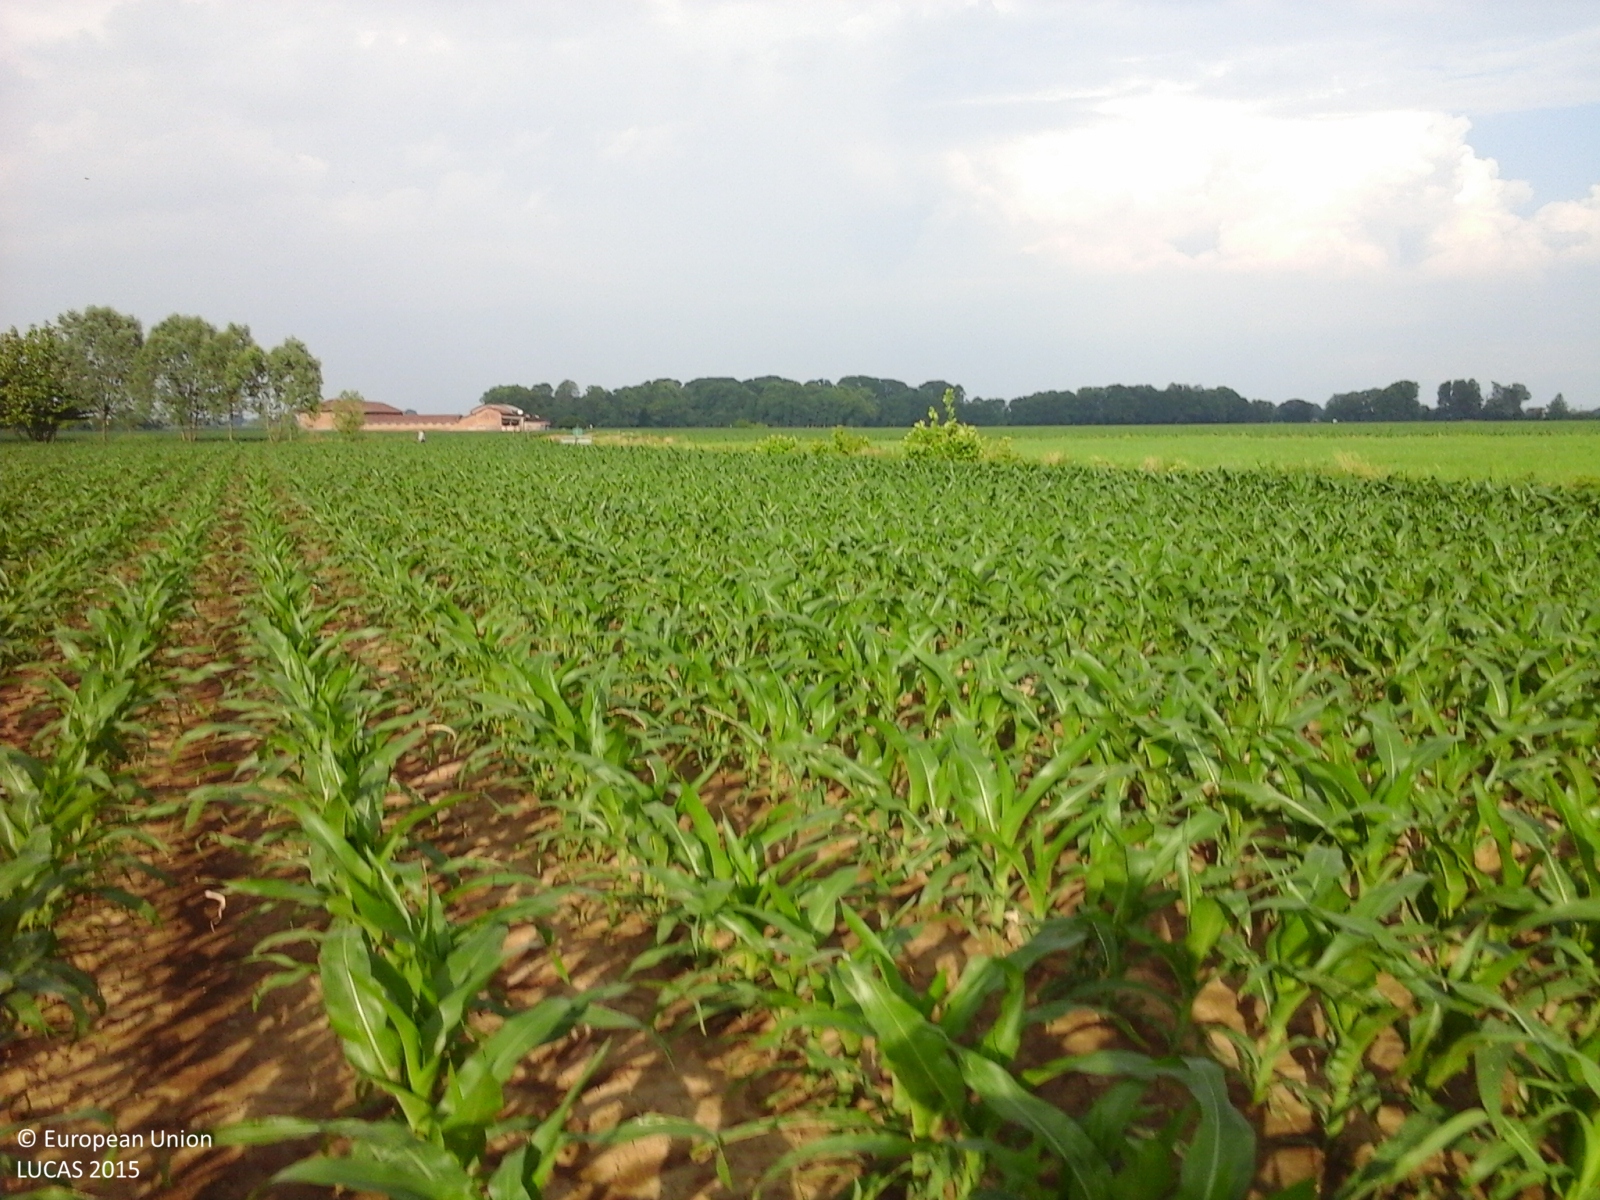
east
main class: Cropland
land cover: Maize
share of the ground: 25 - 50 %
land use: Agriculture (excluding fallow land and kitchen gardens)
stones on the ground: < 10 %
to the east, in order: Maize; Grass margins; Ditches and canals; Grass margins; Temporary grasslands; Grass margins; Ditches and canals; Grass margins; Tracks; Grass margins; Maize
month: May
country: IT
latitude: 45.5219
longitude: 9.6549
